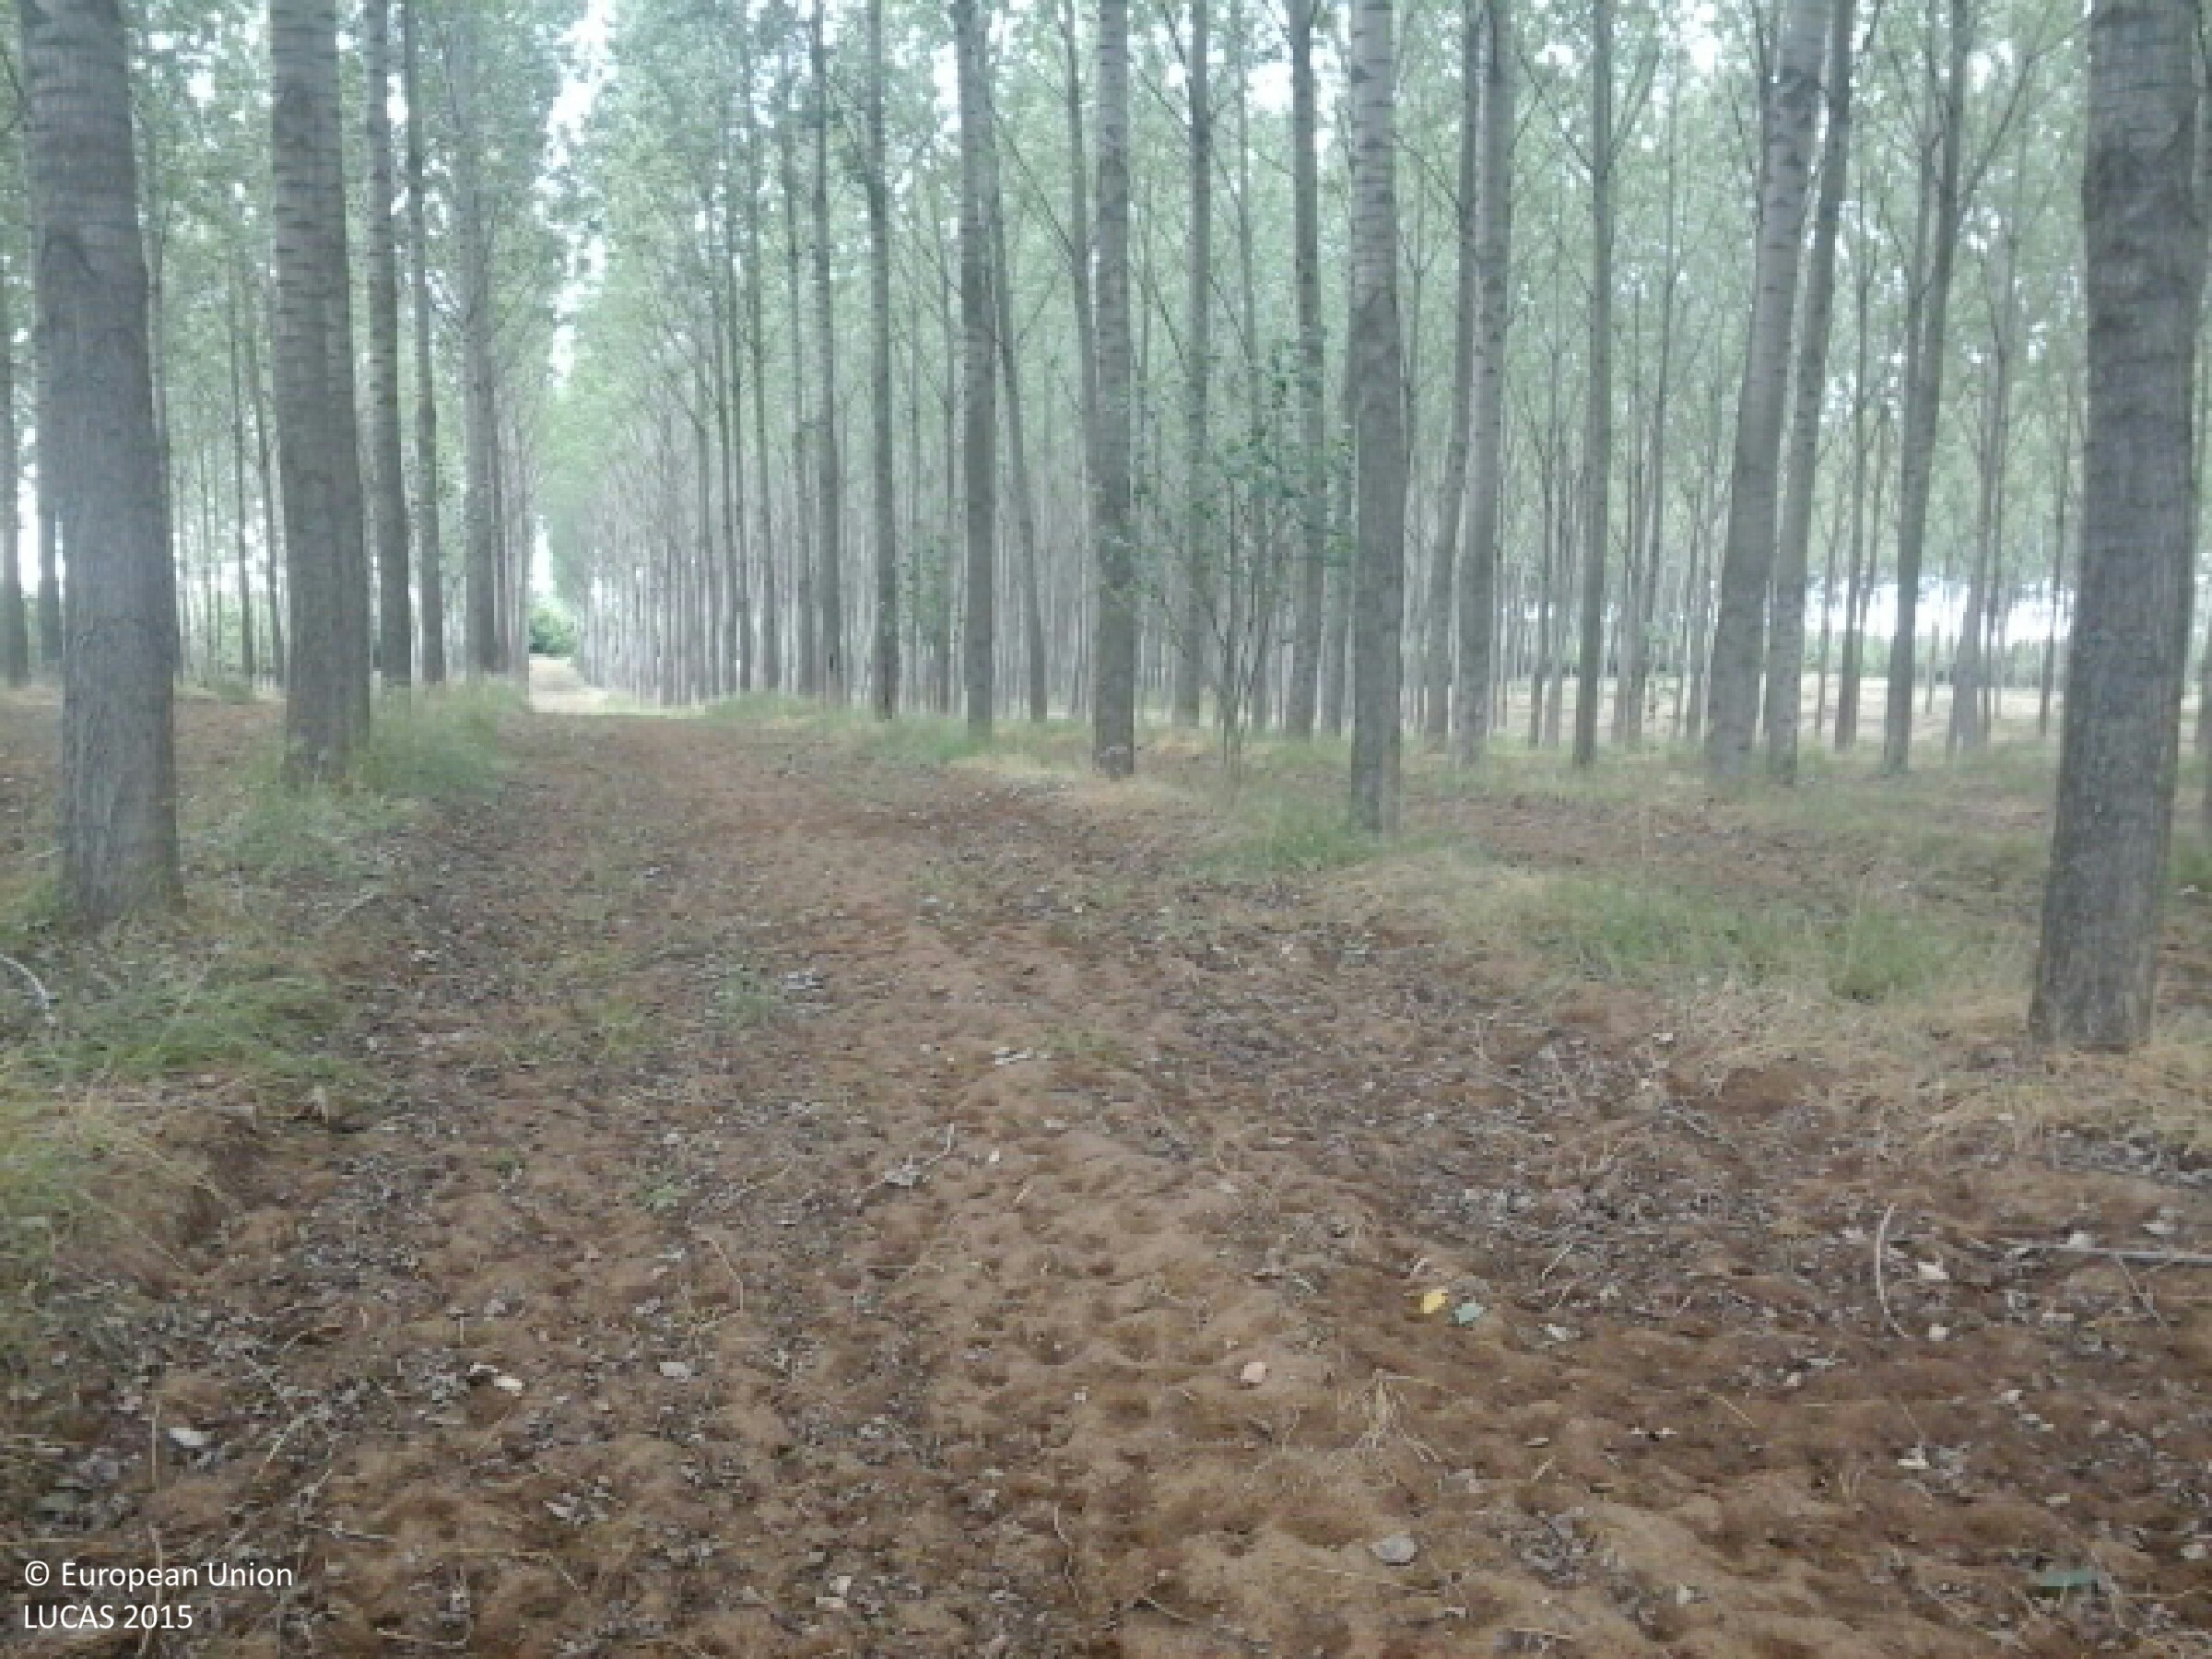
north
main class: Woodland
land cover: Broadleaved woodland
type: non-riverine alder, birch or aspen forest
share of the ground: > 75 %
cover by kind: broadleaved forest trees 100 %
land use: Forestry
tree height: > 5 m
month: June
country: HU
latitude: 48.0735
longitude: 22.1746
